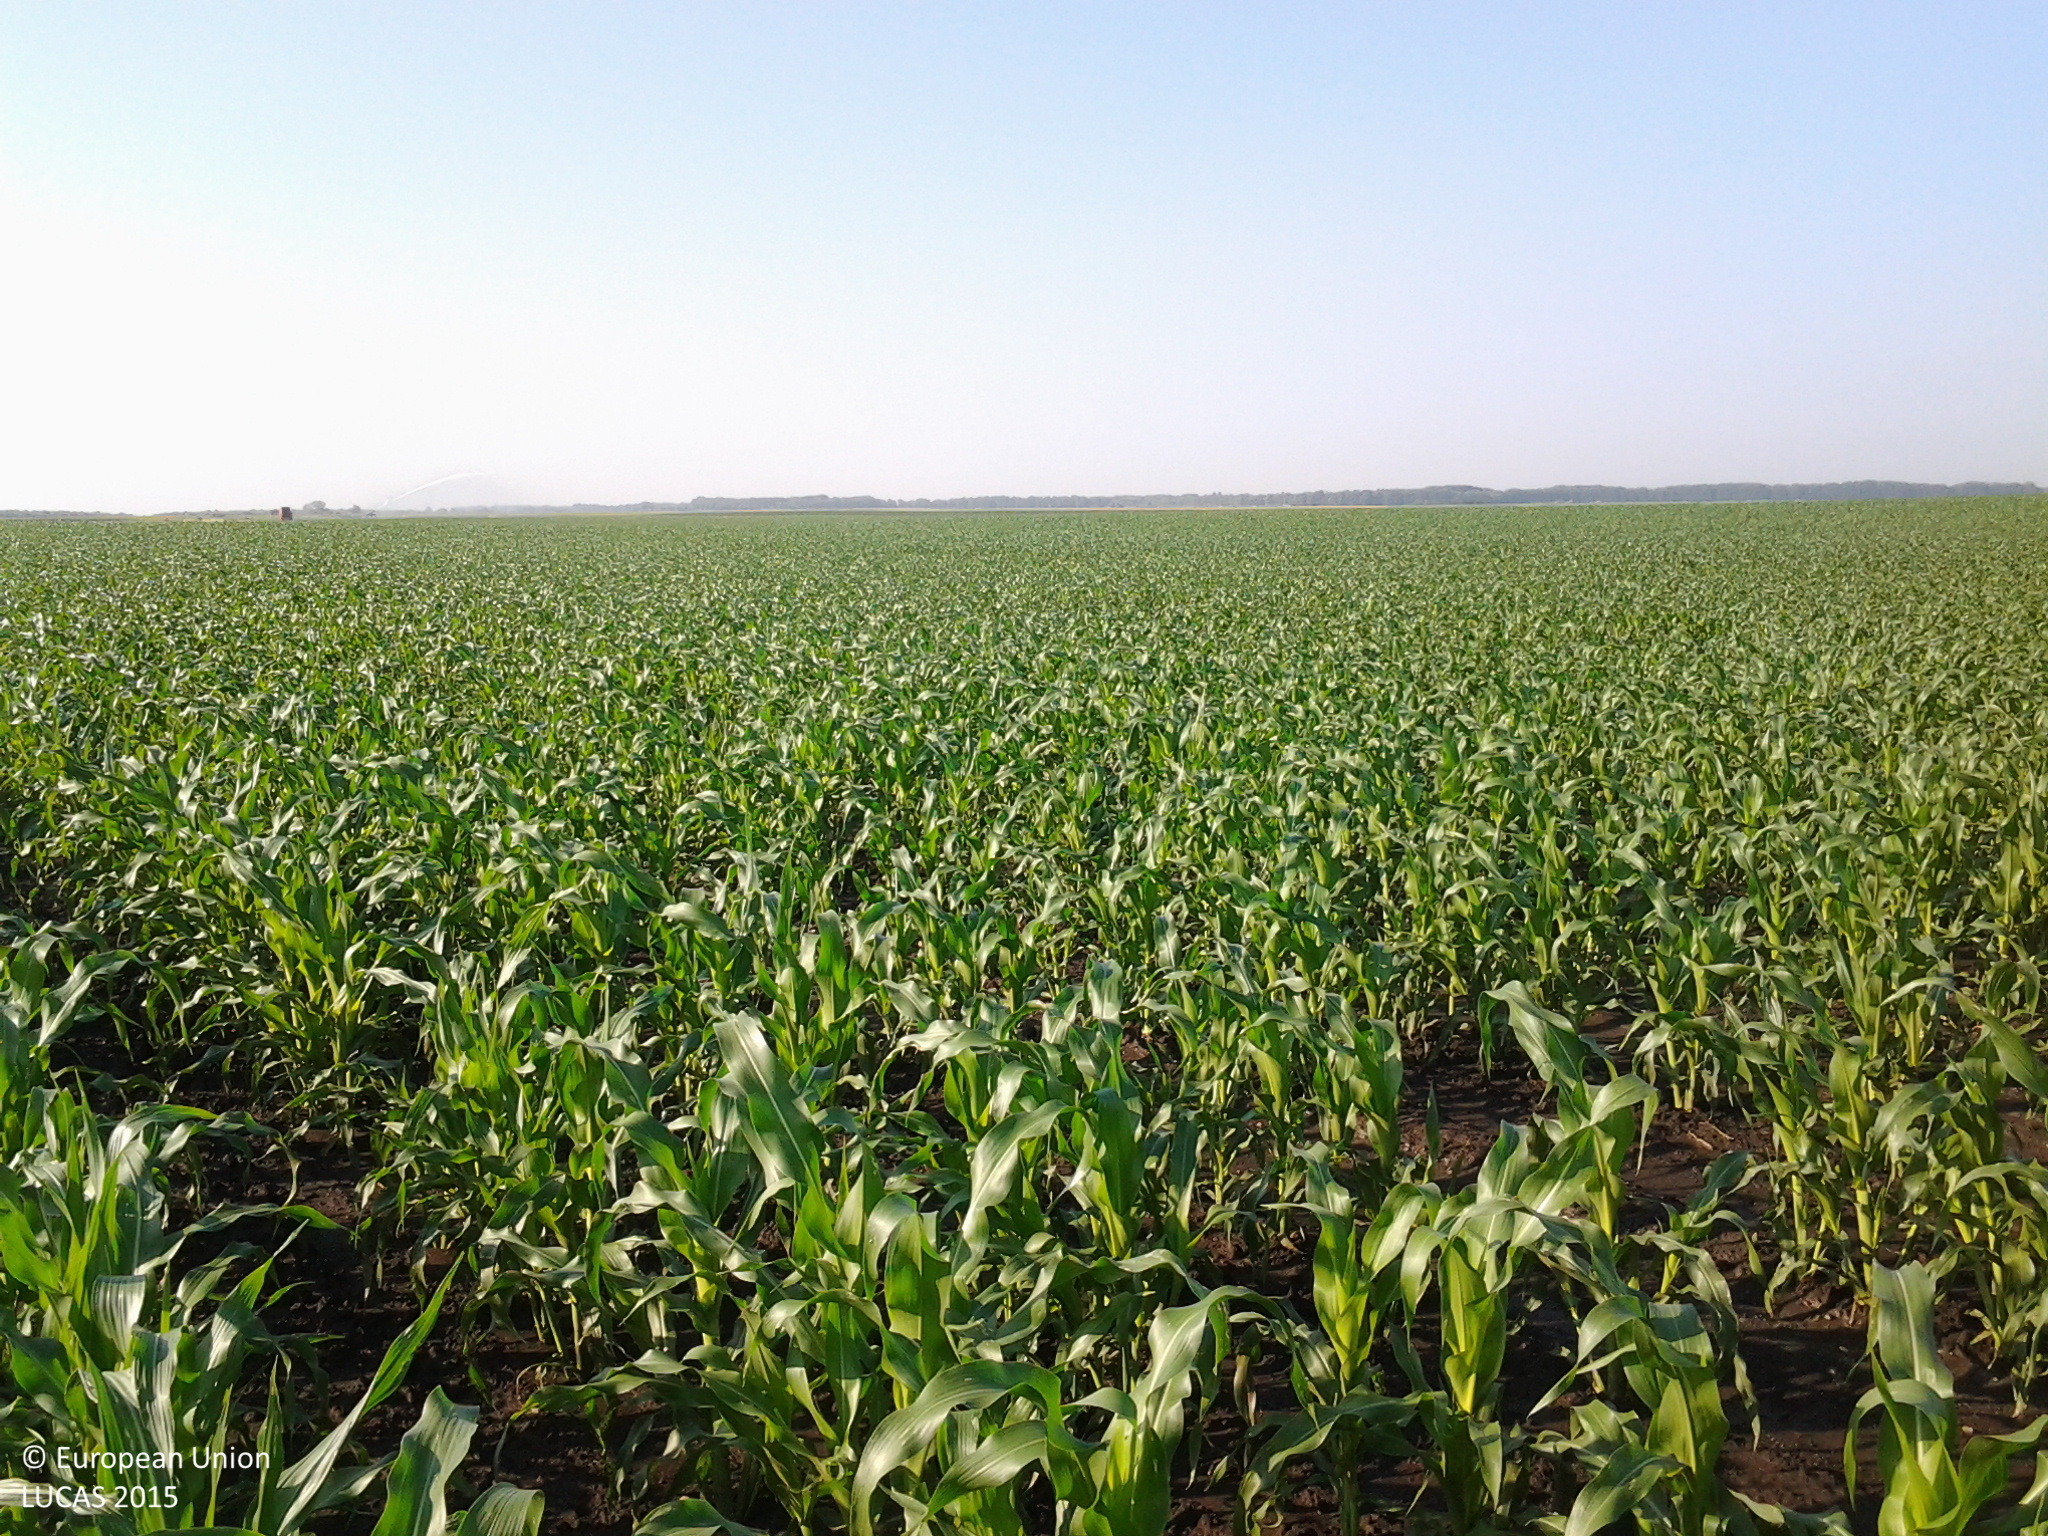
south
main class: Cropland
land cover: Maize
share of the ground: > 75 %
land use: Agriculture (excluding fallow land and kitchen gardens)
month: July
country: HU
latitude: 46.8456
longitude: 19.1562
